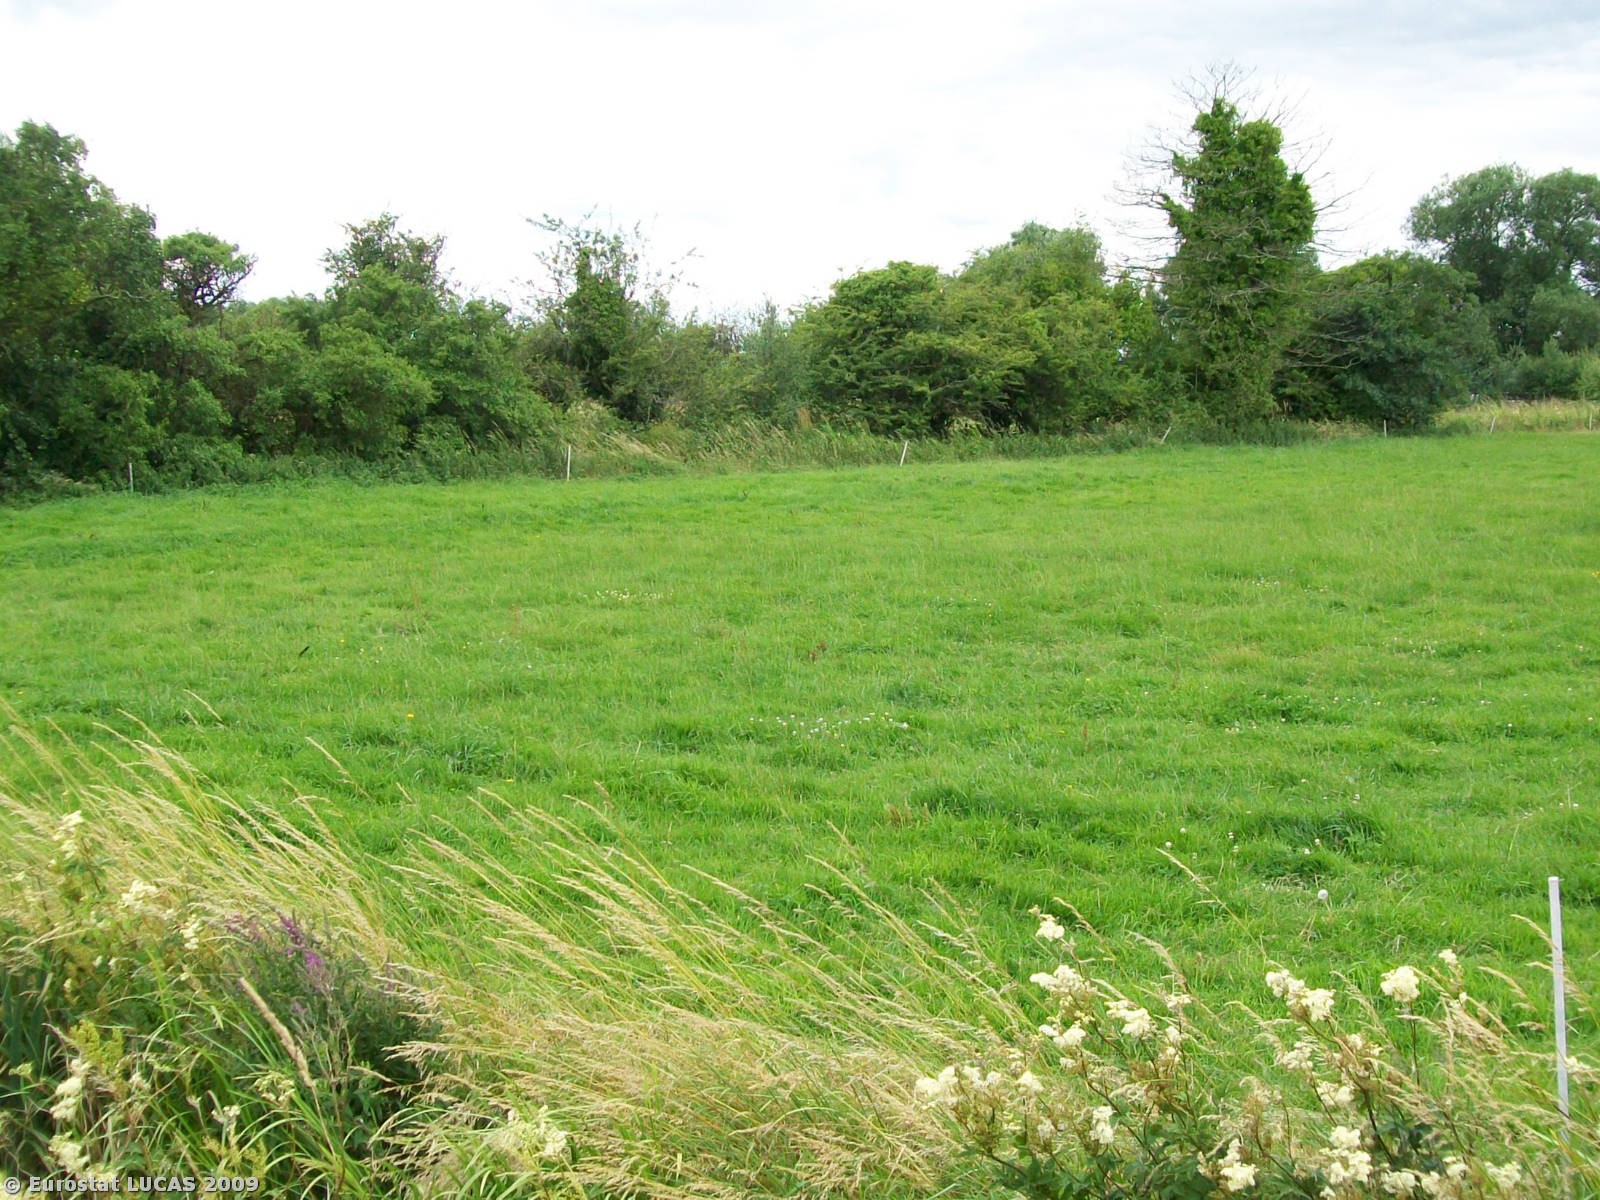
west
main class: Grassland
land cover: Grassland without tree/shrub cover
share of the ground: > 75 %
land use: Agriculture (excluding fallow land and kitchen gardens)
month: July
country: GB
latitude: 51.1610
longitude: -2.7251
